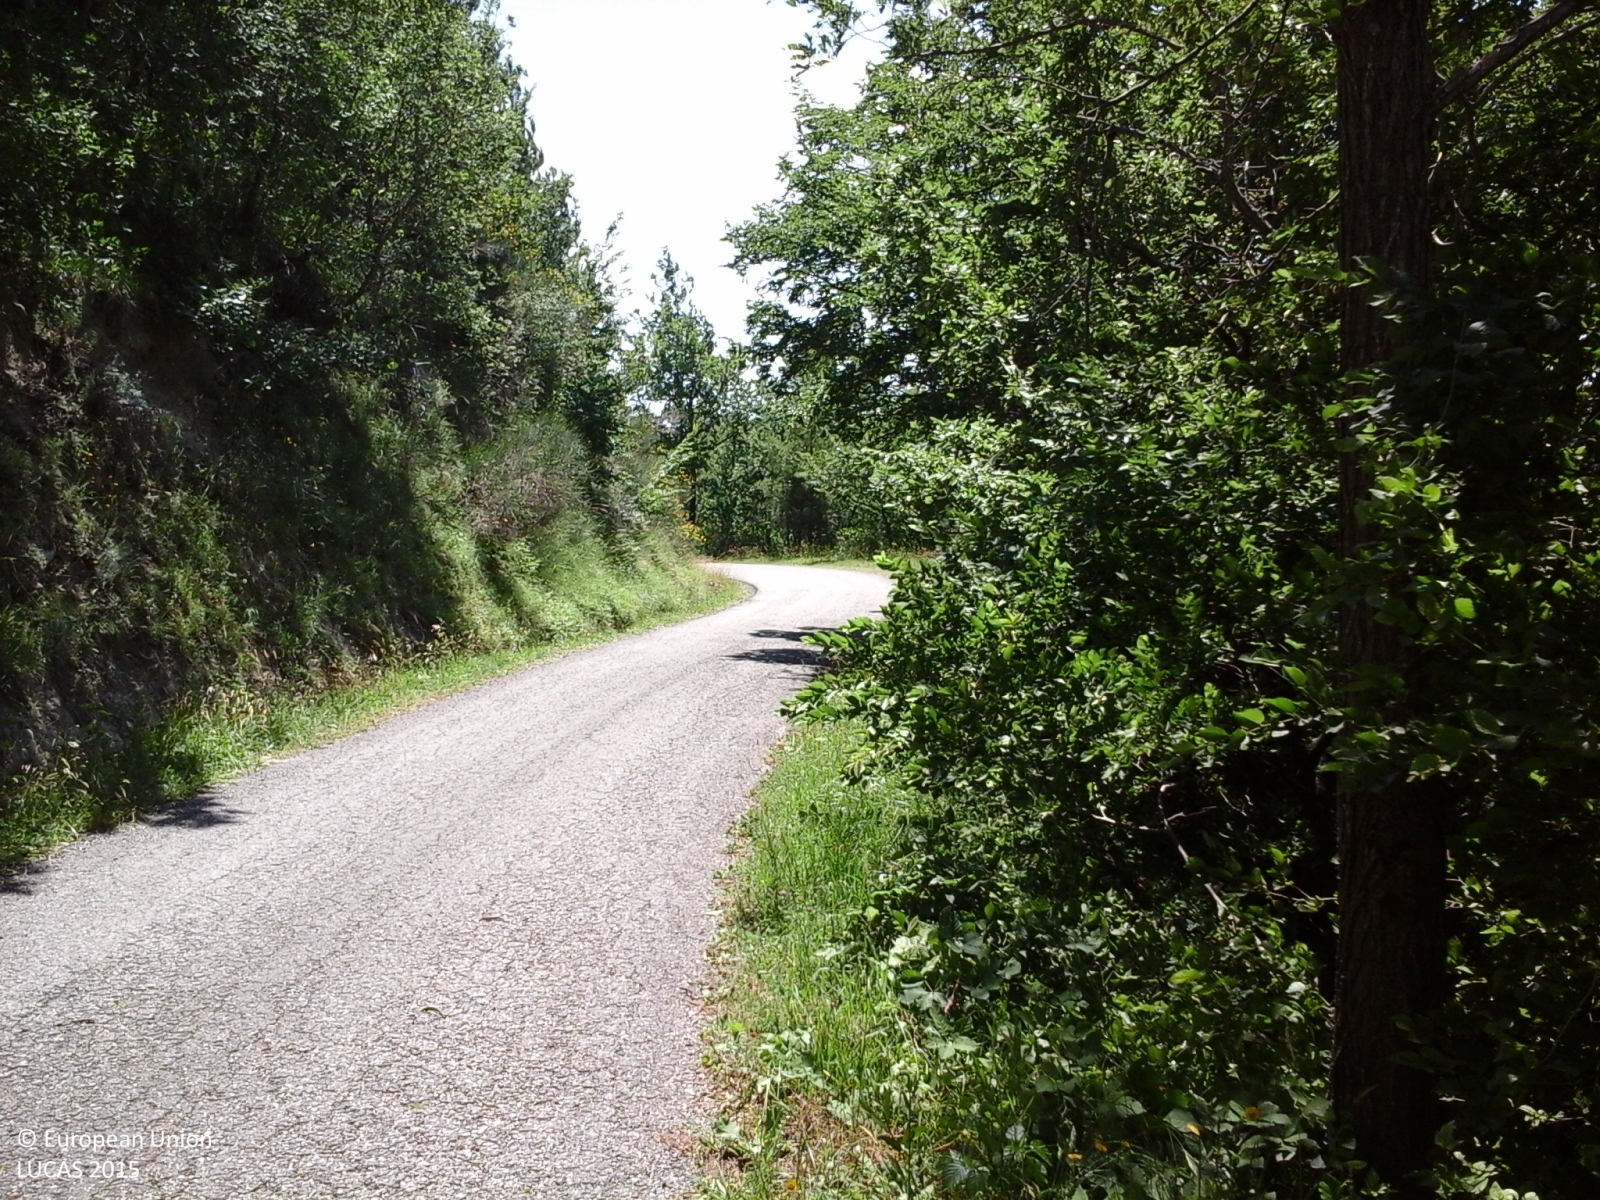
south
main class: Woodland
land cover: Broadleaved woodland
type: acidophilous oak and oak-birch forest
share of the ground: > 75 %
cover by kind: broadleaved forest trees 95 %, shrubs 5 %
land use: Forestry
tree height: > 5 m
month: June
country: IT
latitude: 44.2302
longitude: 11.5863
